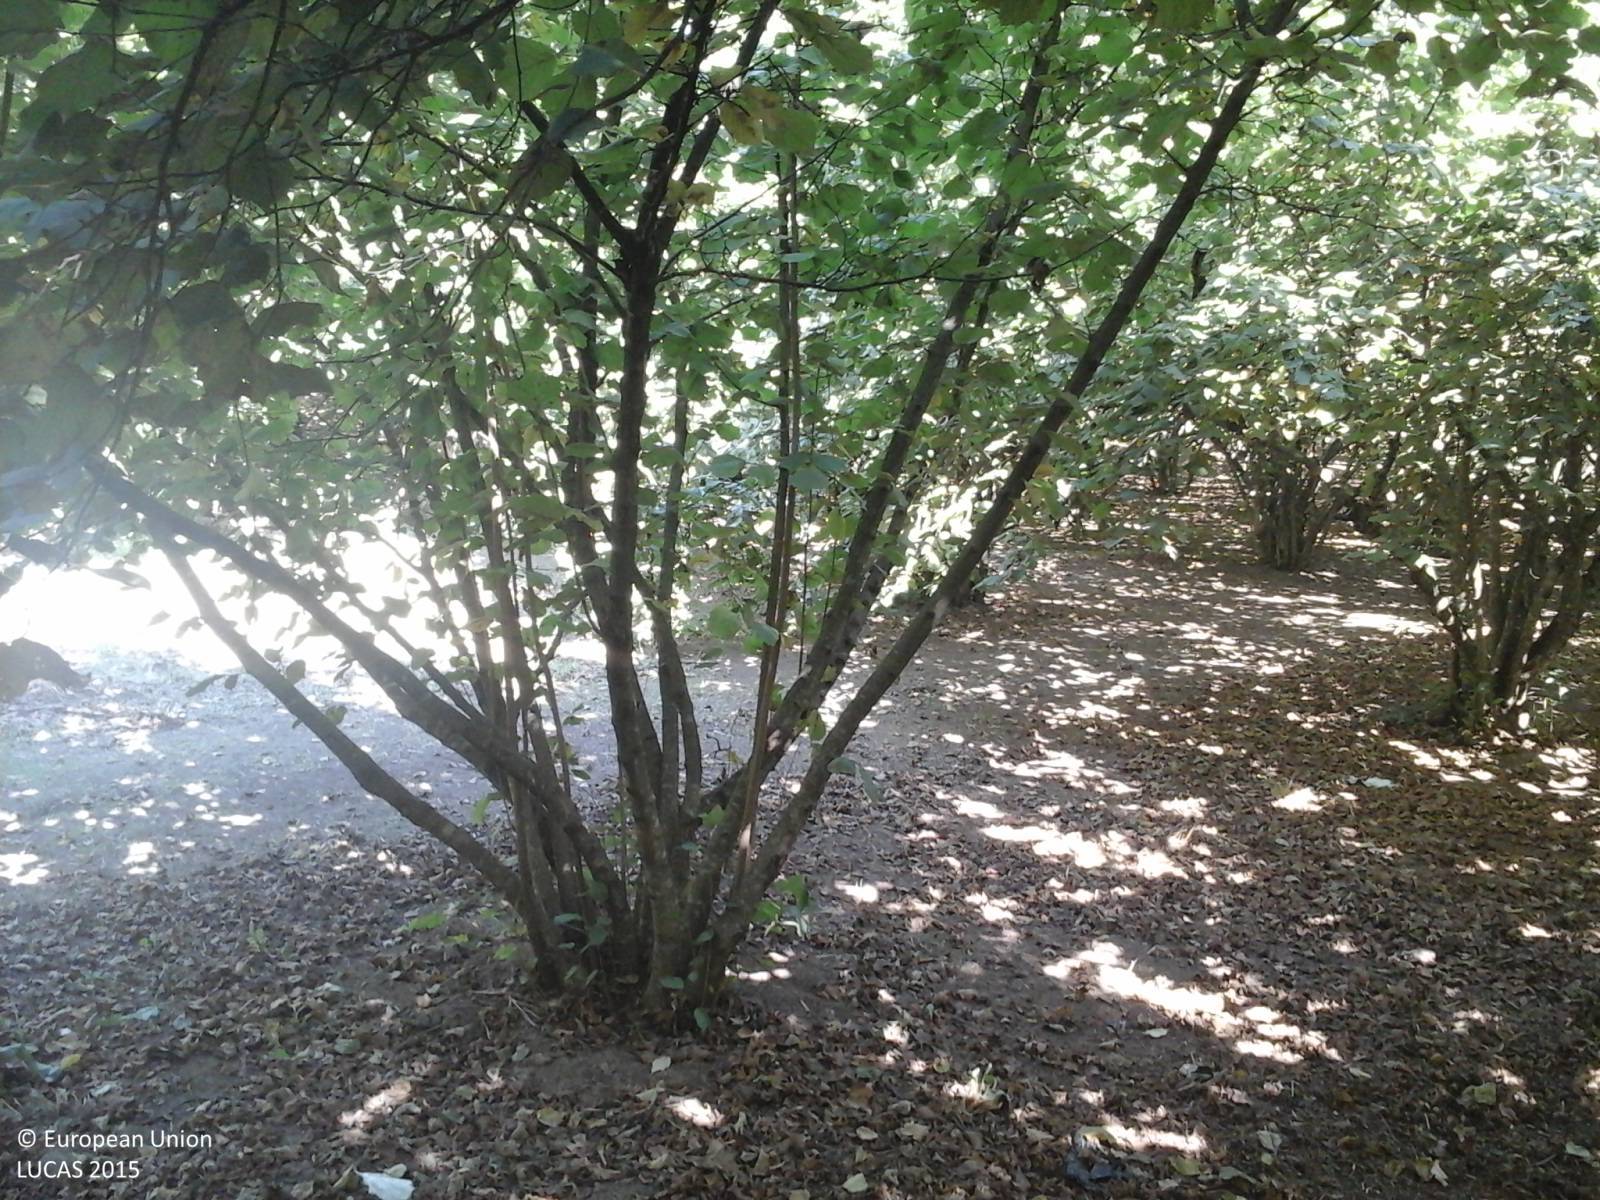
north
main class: Cropland
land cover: Nuts trees
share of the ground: > 75 %
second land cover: Other bare soil
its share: > 75 %
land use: Agriculture (excluding fallow land and kitchen gardens)
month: September
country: IT
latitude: 42.3752
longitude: 12.2875
